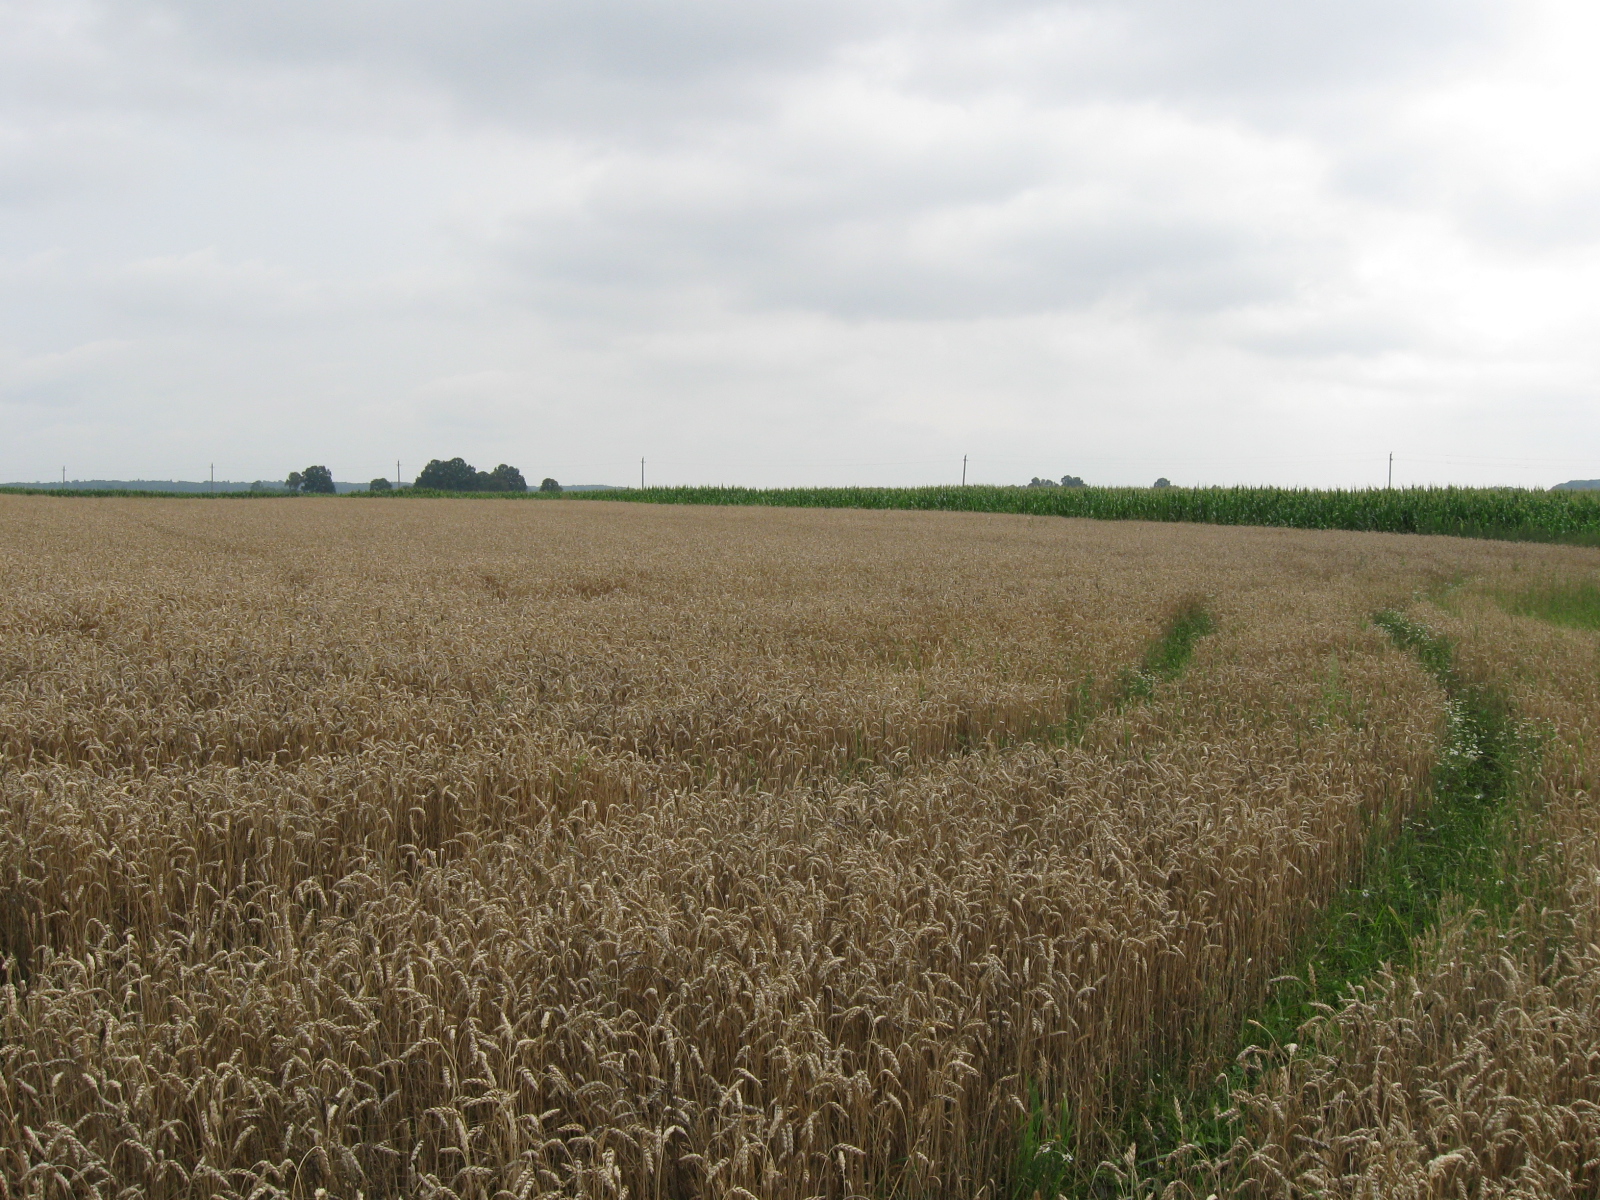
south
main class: Cropland
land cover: Common wheat
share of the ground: > 75 %
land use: Agriculture (excluding fallow land and kitchen gardens)
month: August
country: LT
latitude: 54.6465
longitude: 23.5177
